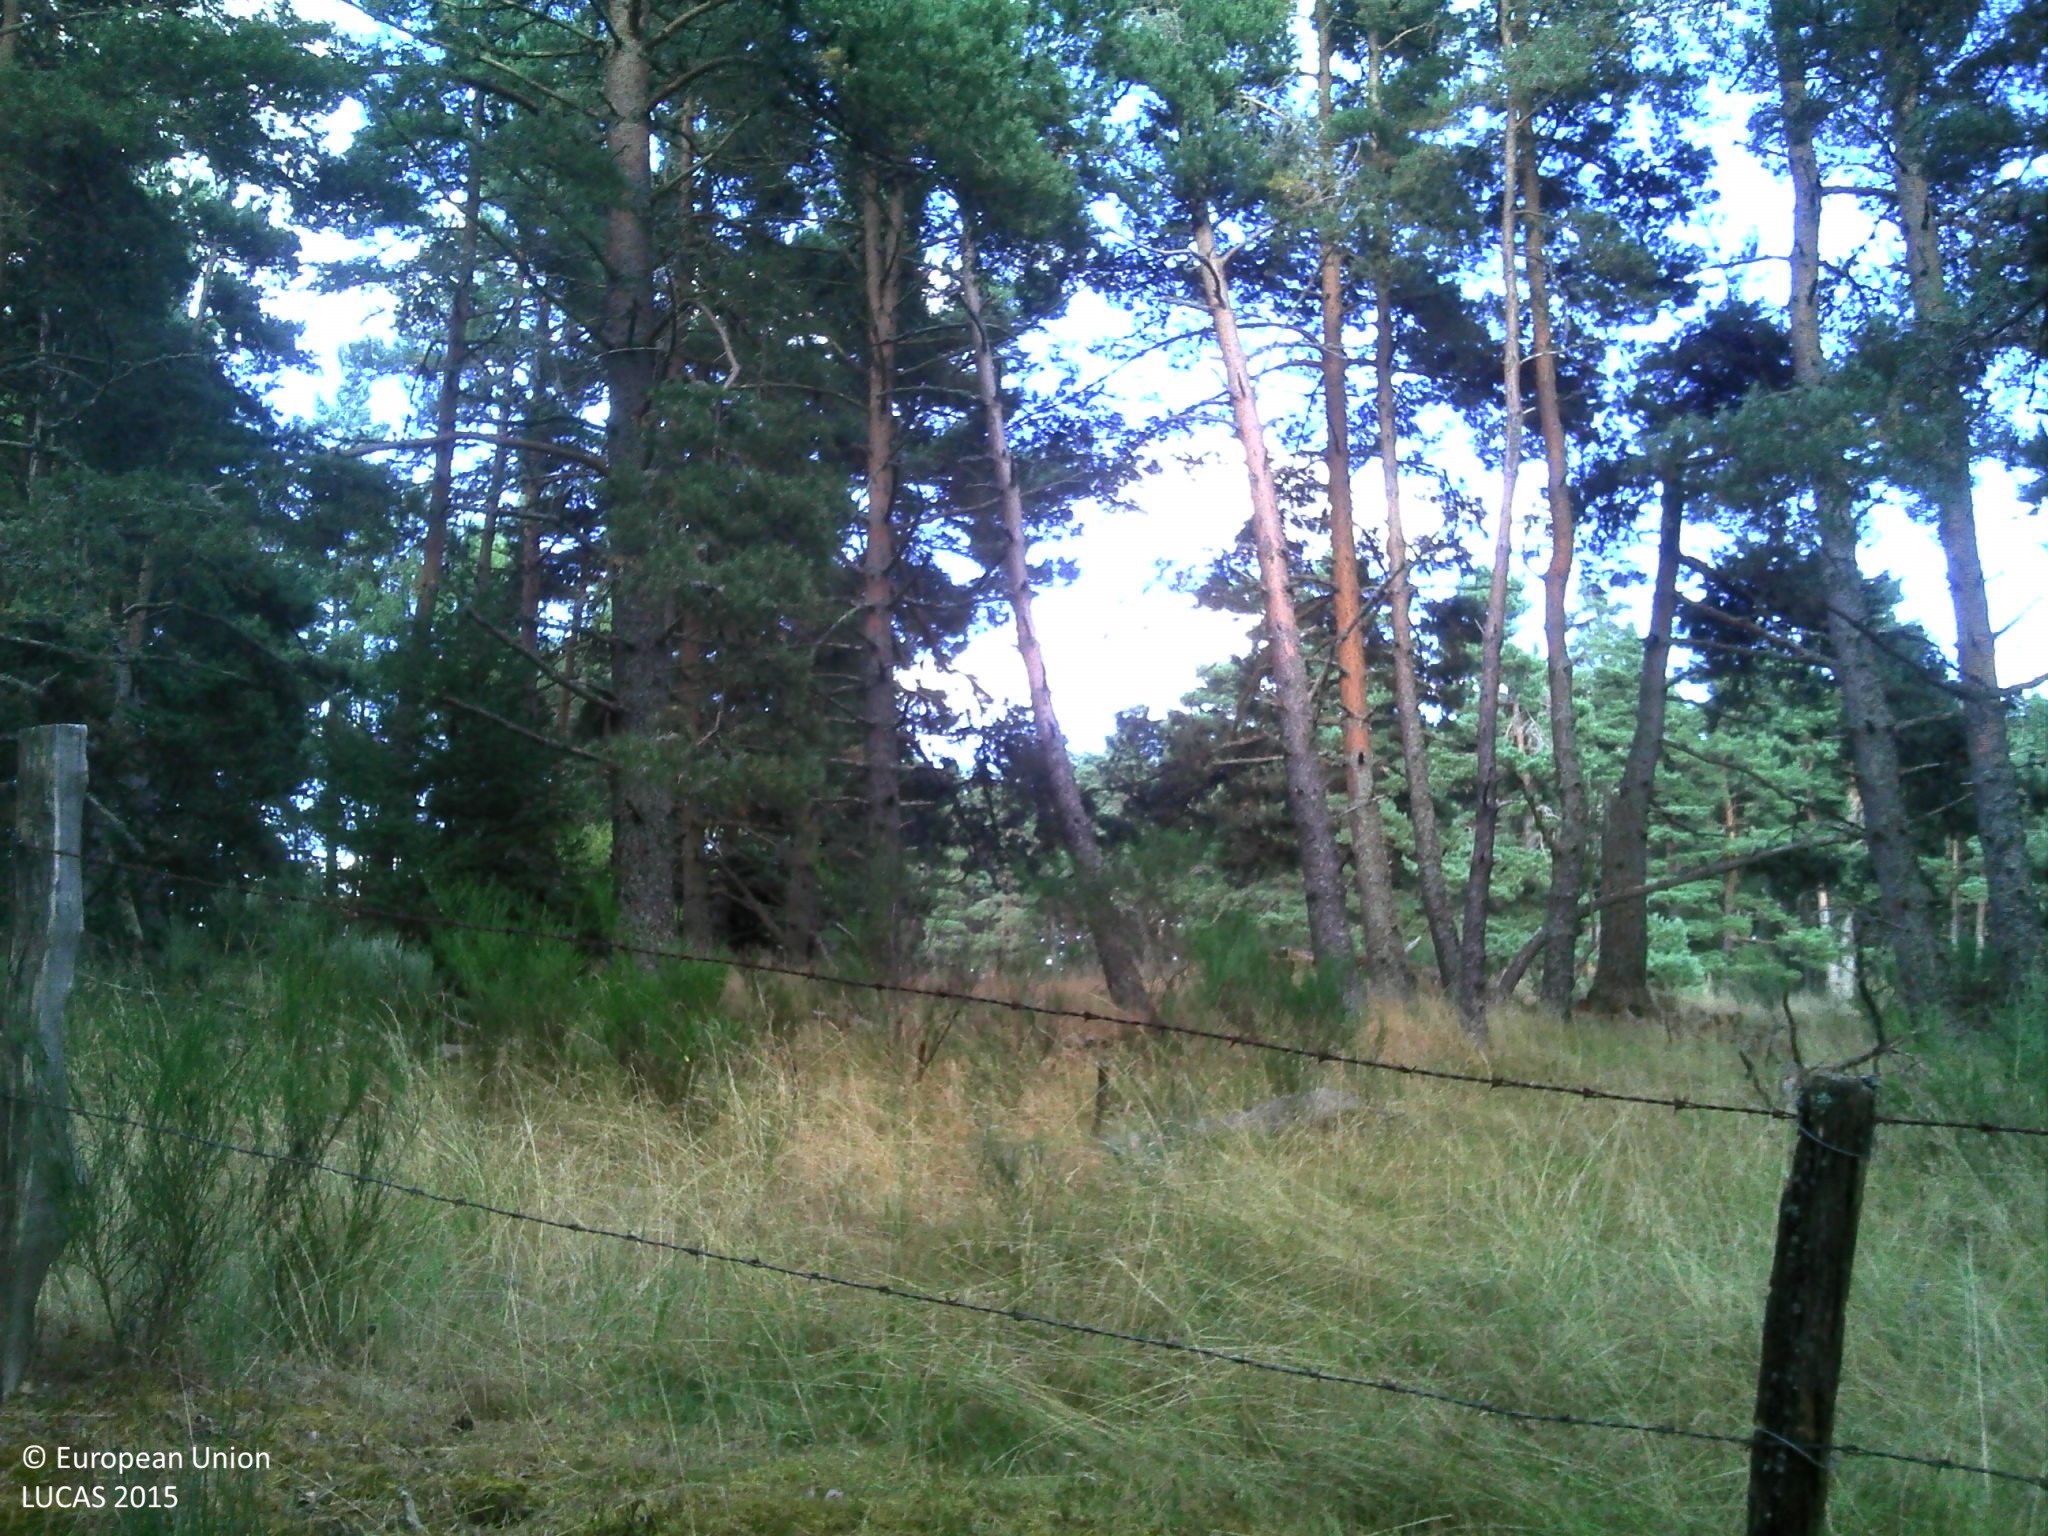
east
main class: Woodland
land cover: Pine dominated coniferous woodland
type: alpine coniferous forest
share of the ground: > 75 %
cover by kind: coniferous forest trees 95 %, broadleaved forest trees 5 %
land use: Forestry
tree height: > 5 m
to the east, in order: Pine dominated coniferous woodland; Fences; Pine dominated coniferous woodland; Grassland without tree/shrub cover; Tracks; Fences; Lines of trees; Grassland without tree/shrub cover; Pine dominated coniferous woodland
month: July
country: FR
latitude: 44.7978
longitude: 3.2150
